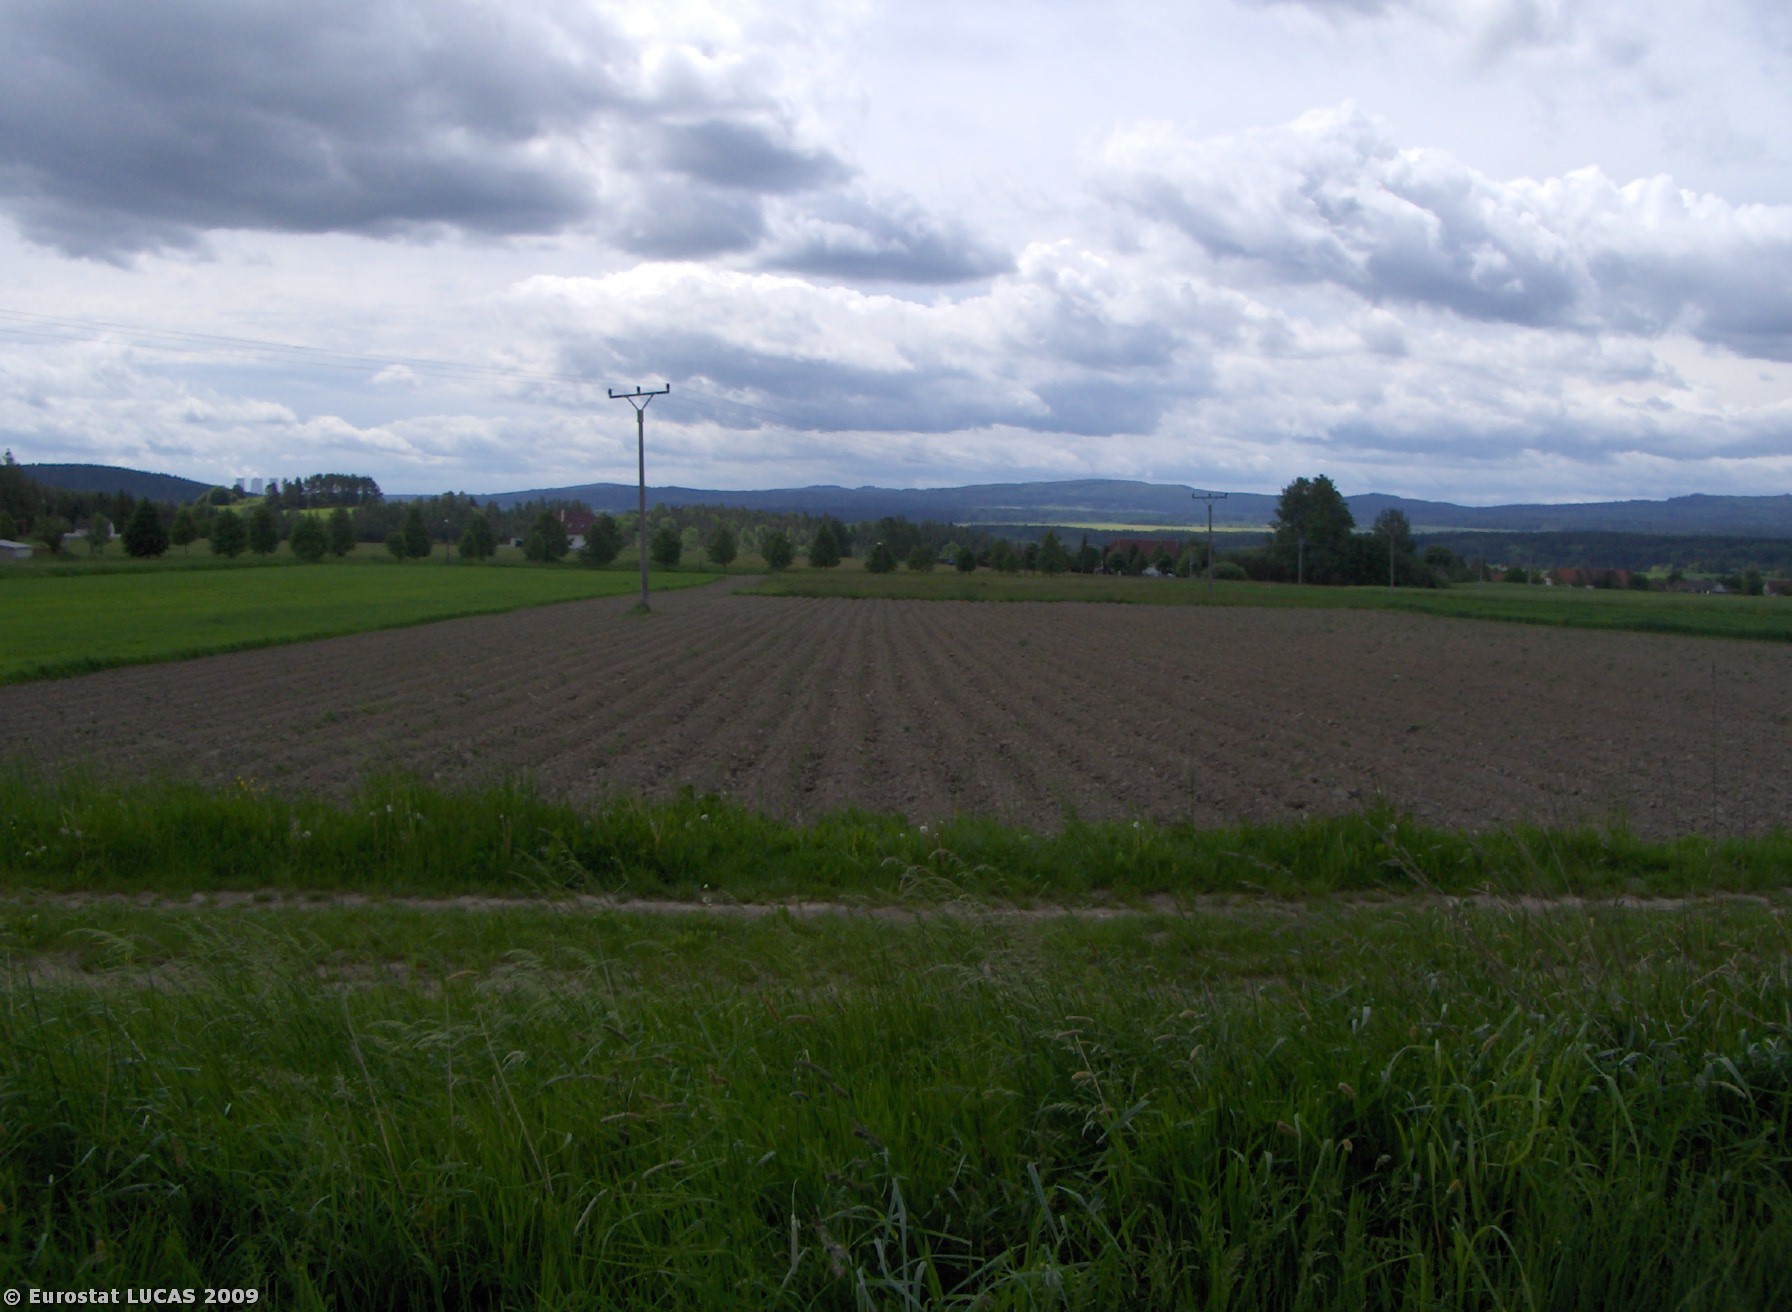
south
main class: Cropland
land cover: Common wheat
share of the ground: > 75 %
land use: Agriculture (excluding fallow land and kitchen gardens)
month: May
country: CZ
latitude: 49.3274
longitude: 14.3353
